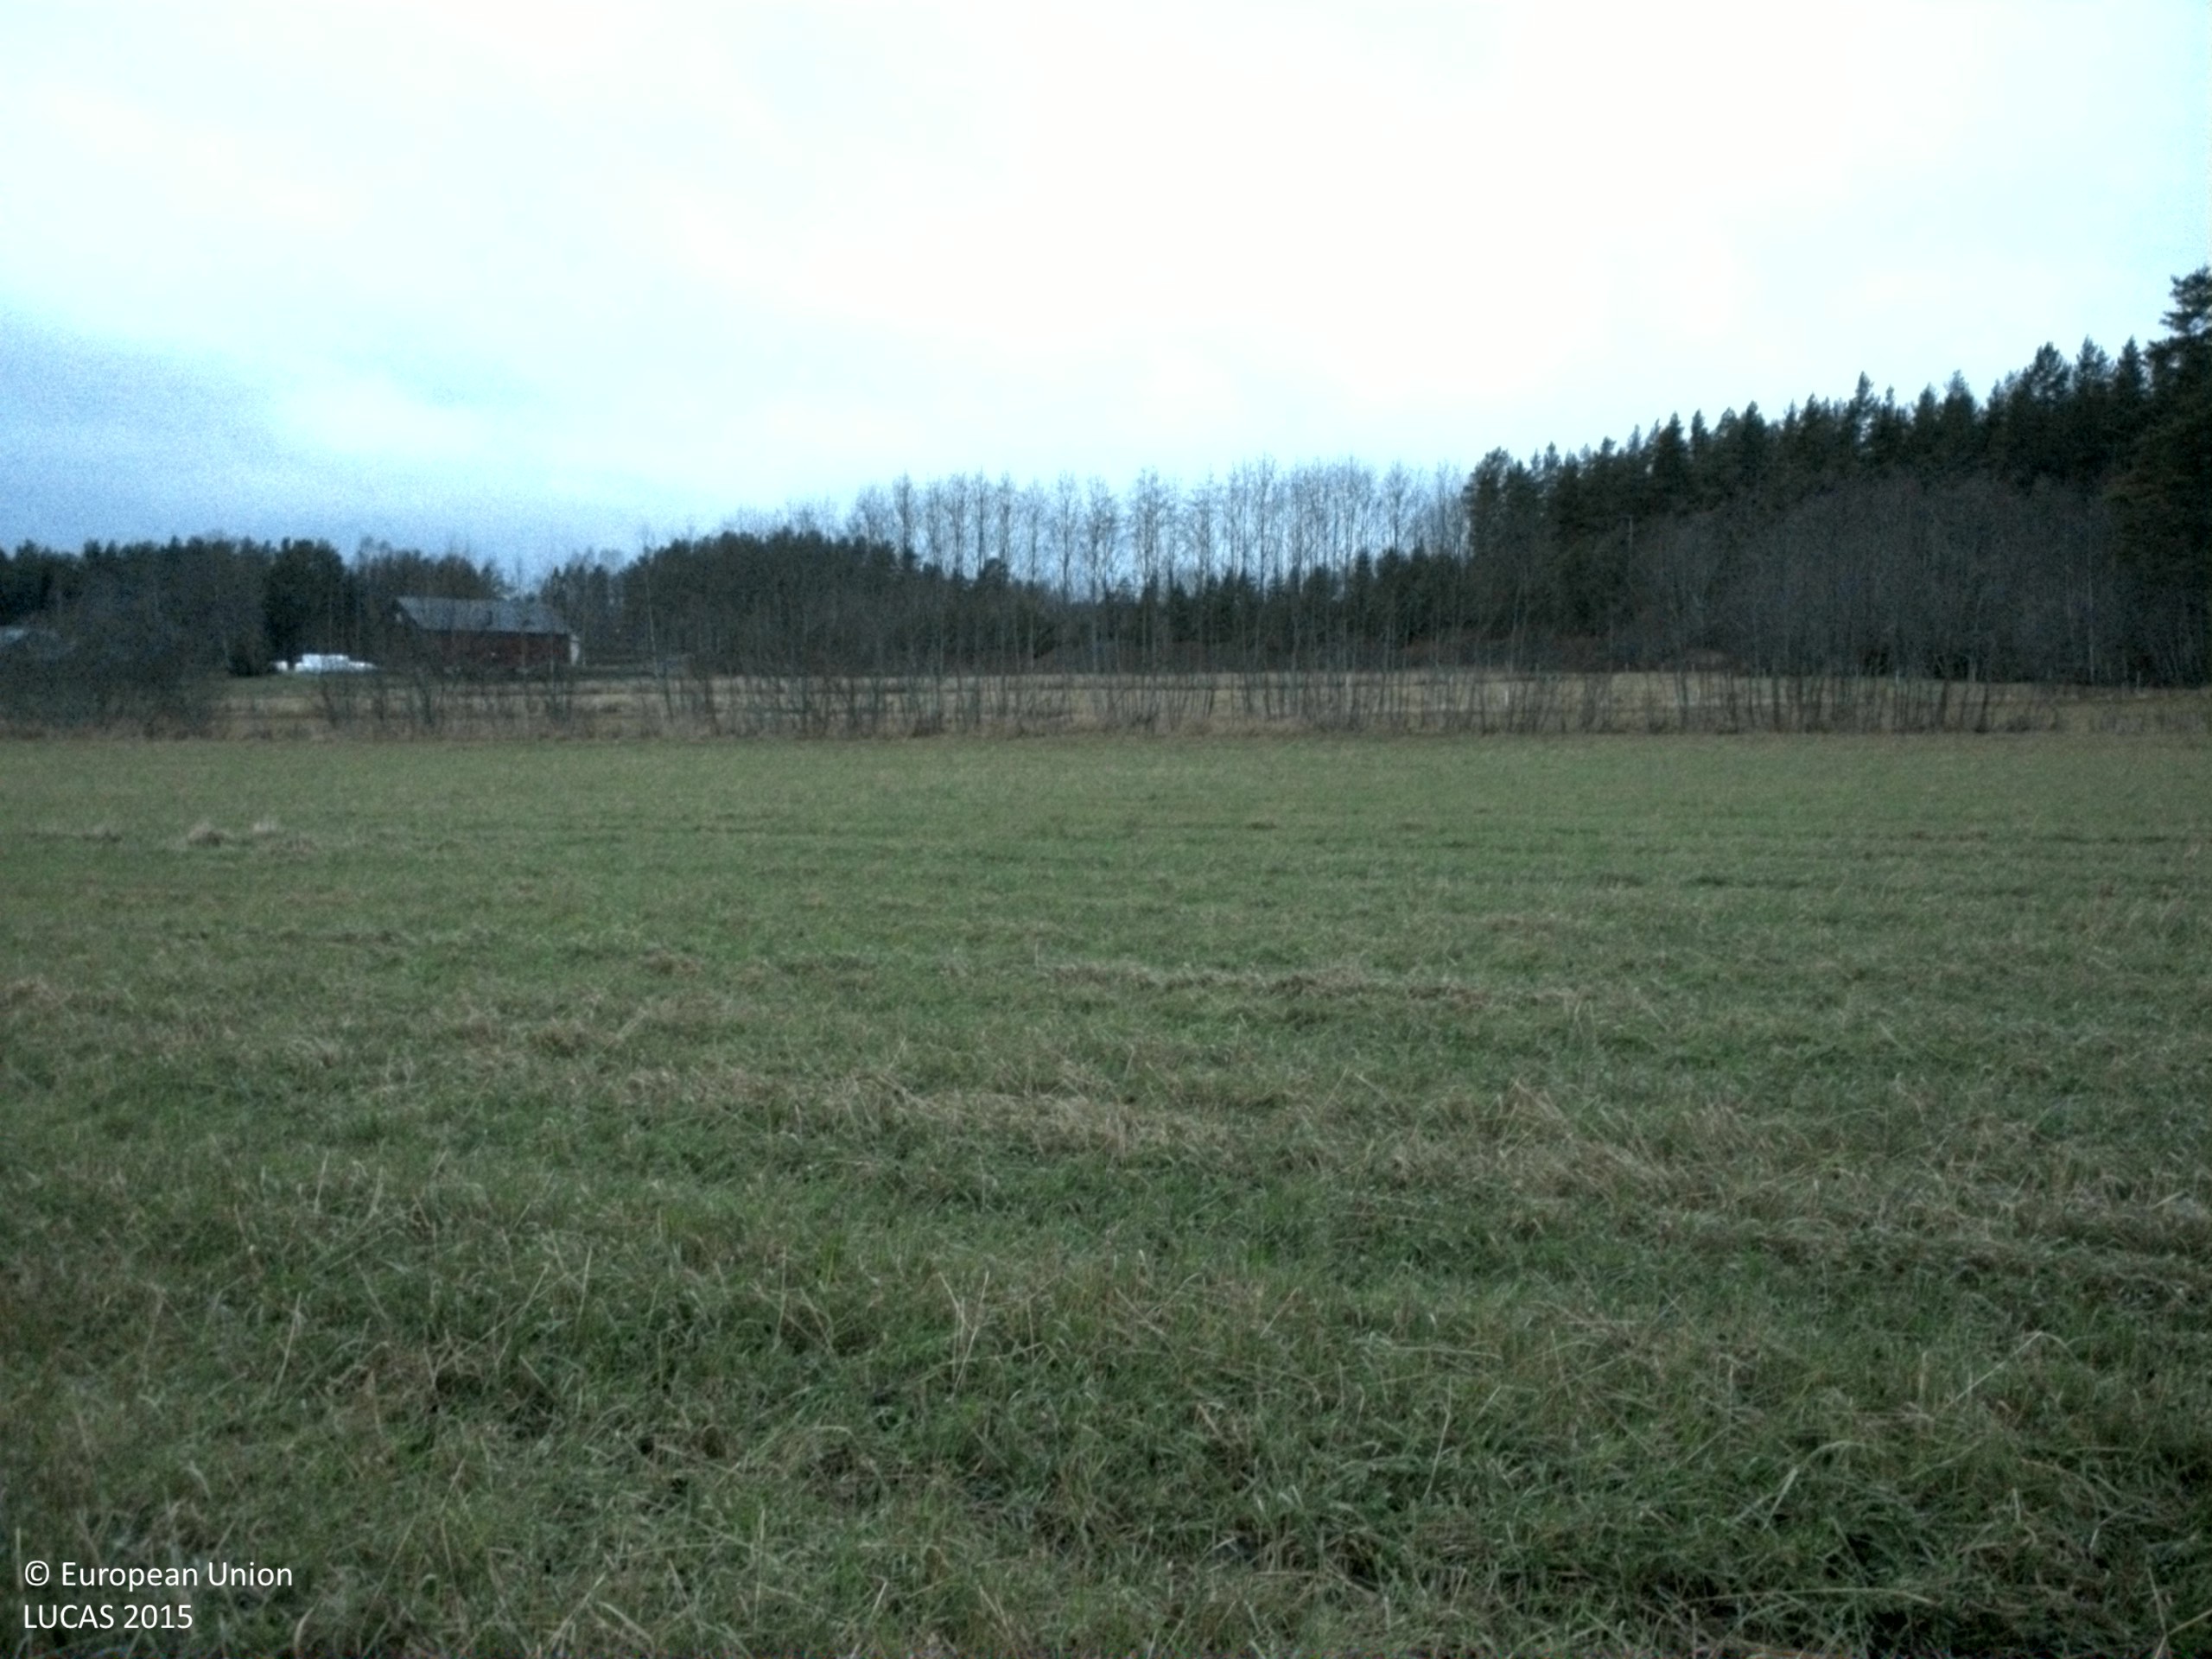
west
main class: Cropland
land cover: Other leguminous and mixtures for fodder
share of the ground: > 75 %
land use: Agriculture (excluding fallow land and kitchen gardens)
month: November
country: SE
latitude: 61.4923
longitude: 16.9529
